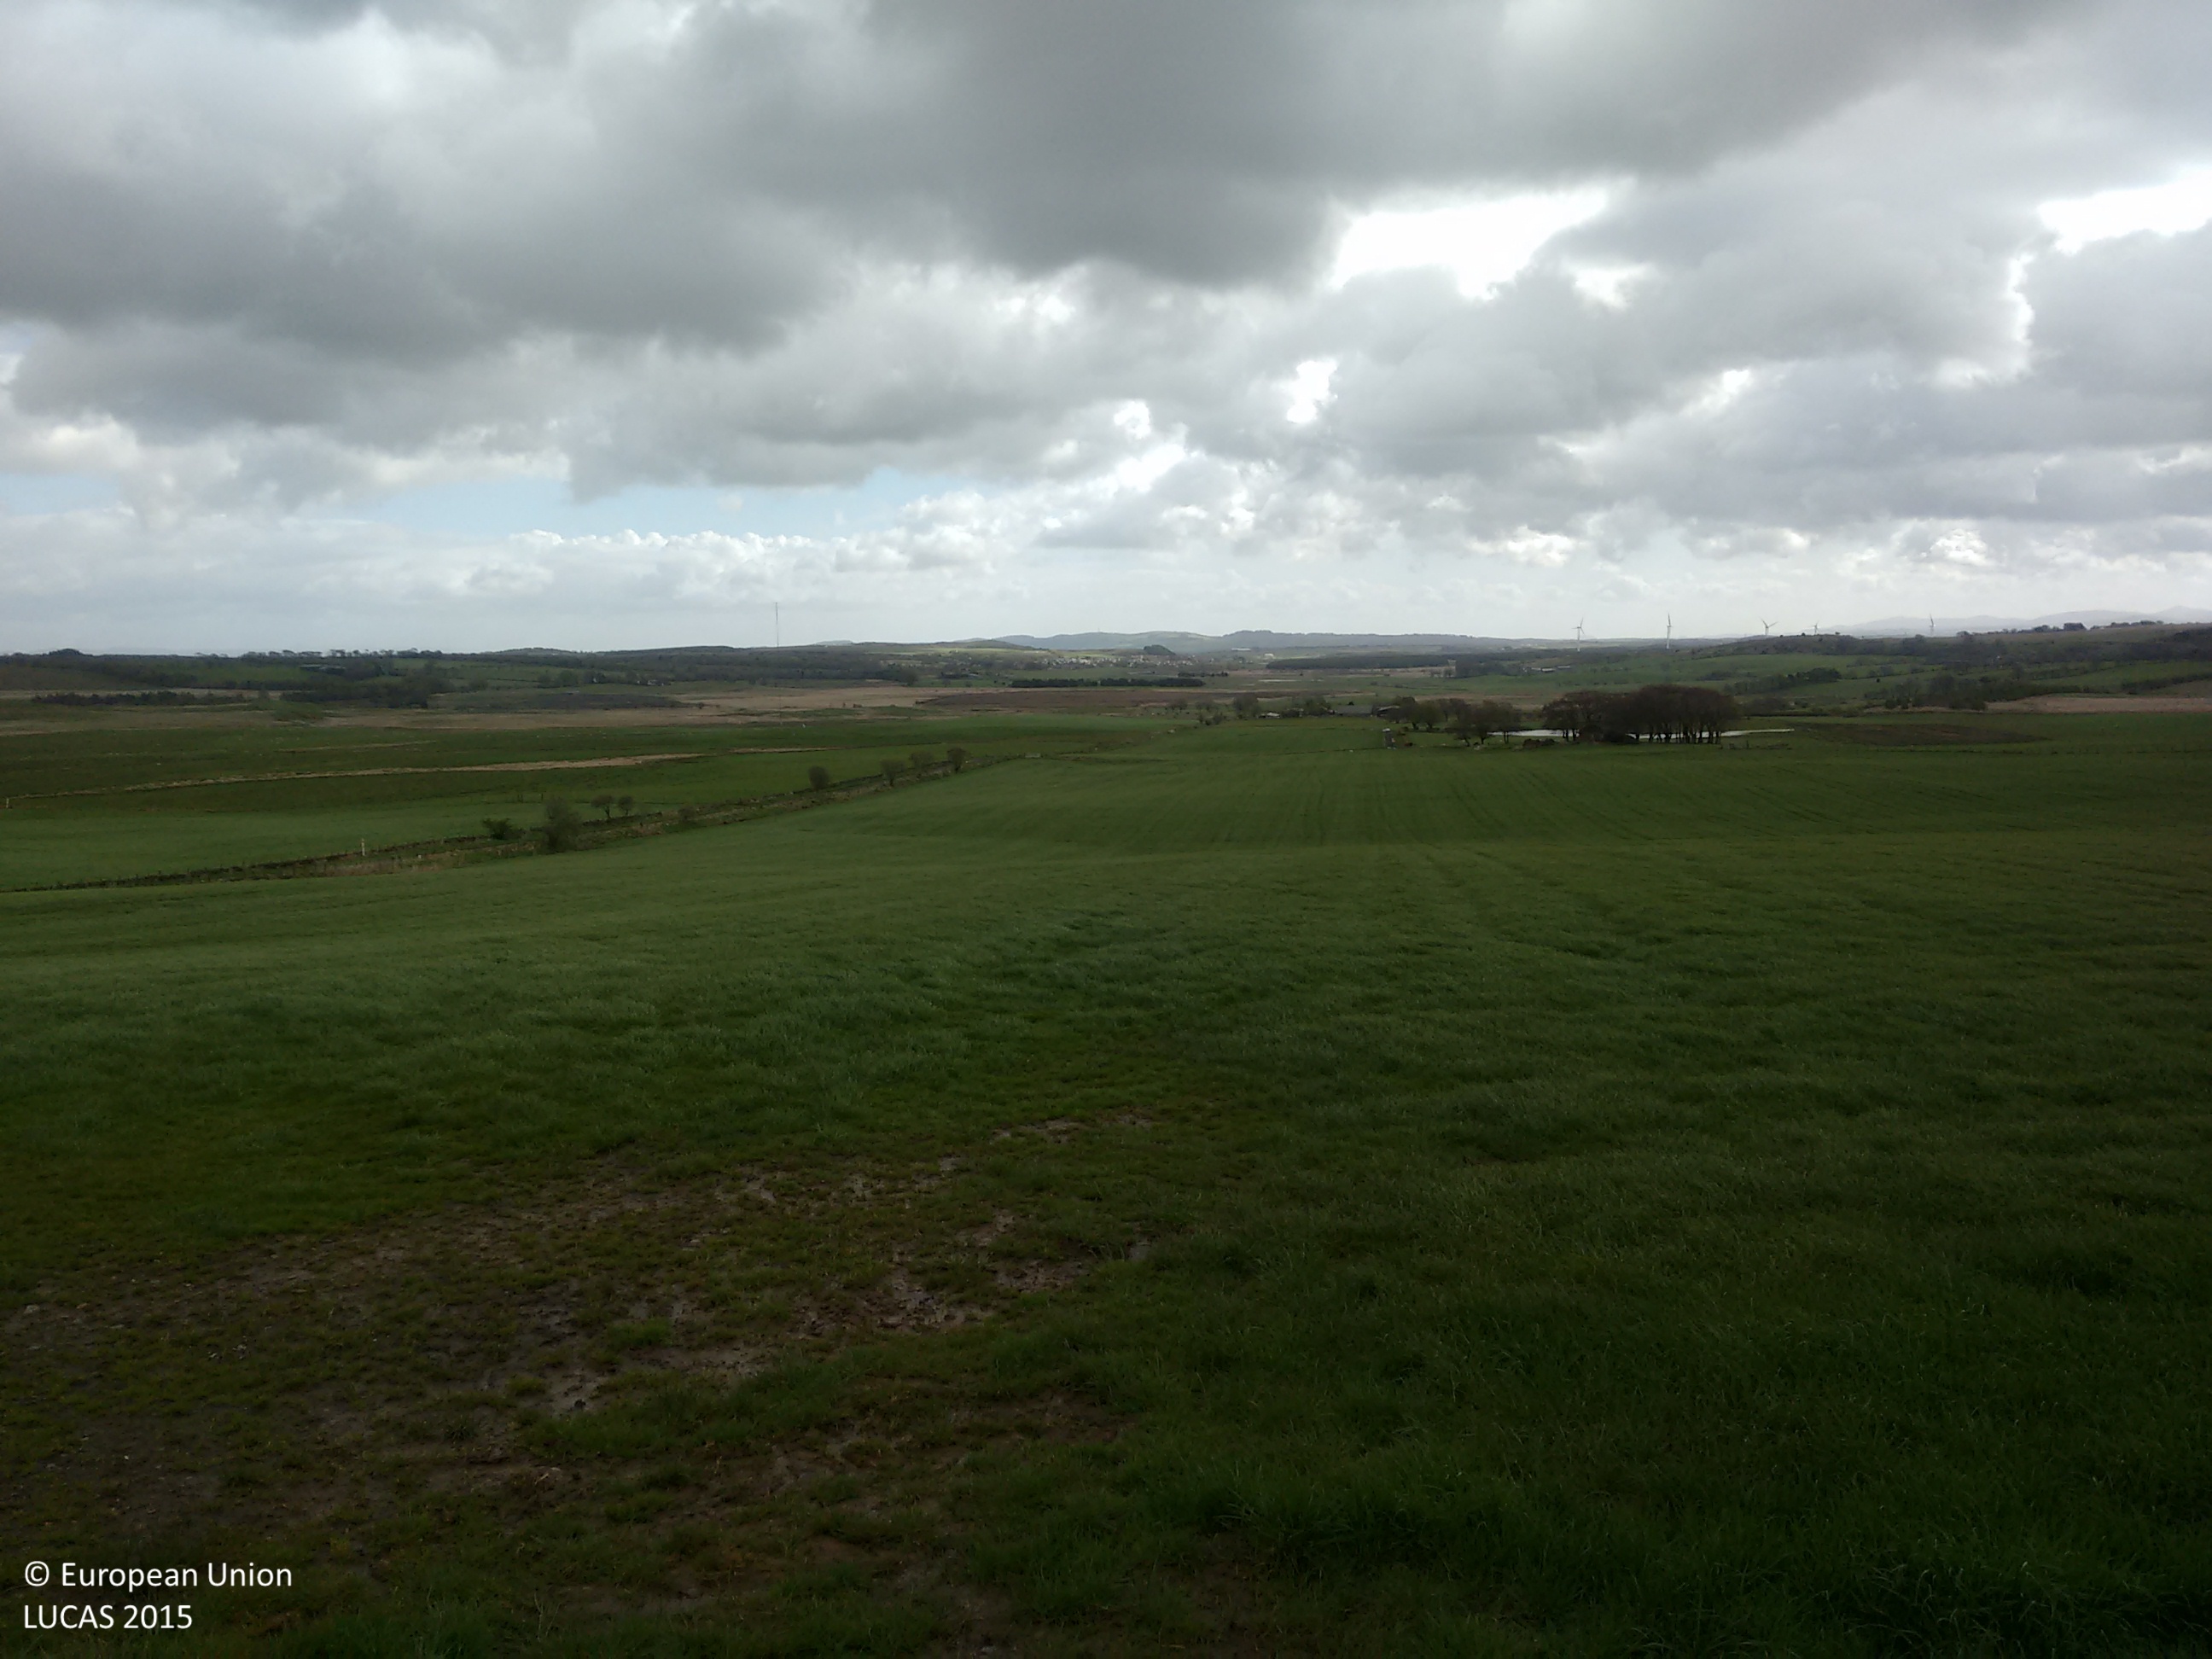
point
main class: Grassland
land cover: Grassland without tree/shrub cover
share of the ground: > 75 %
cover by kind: herbaceous plants 100 %
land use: Agriculture (excluding fallow land and kitchen gardens)
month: May
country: GB
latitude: 55.8743
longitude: -3.8132
